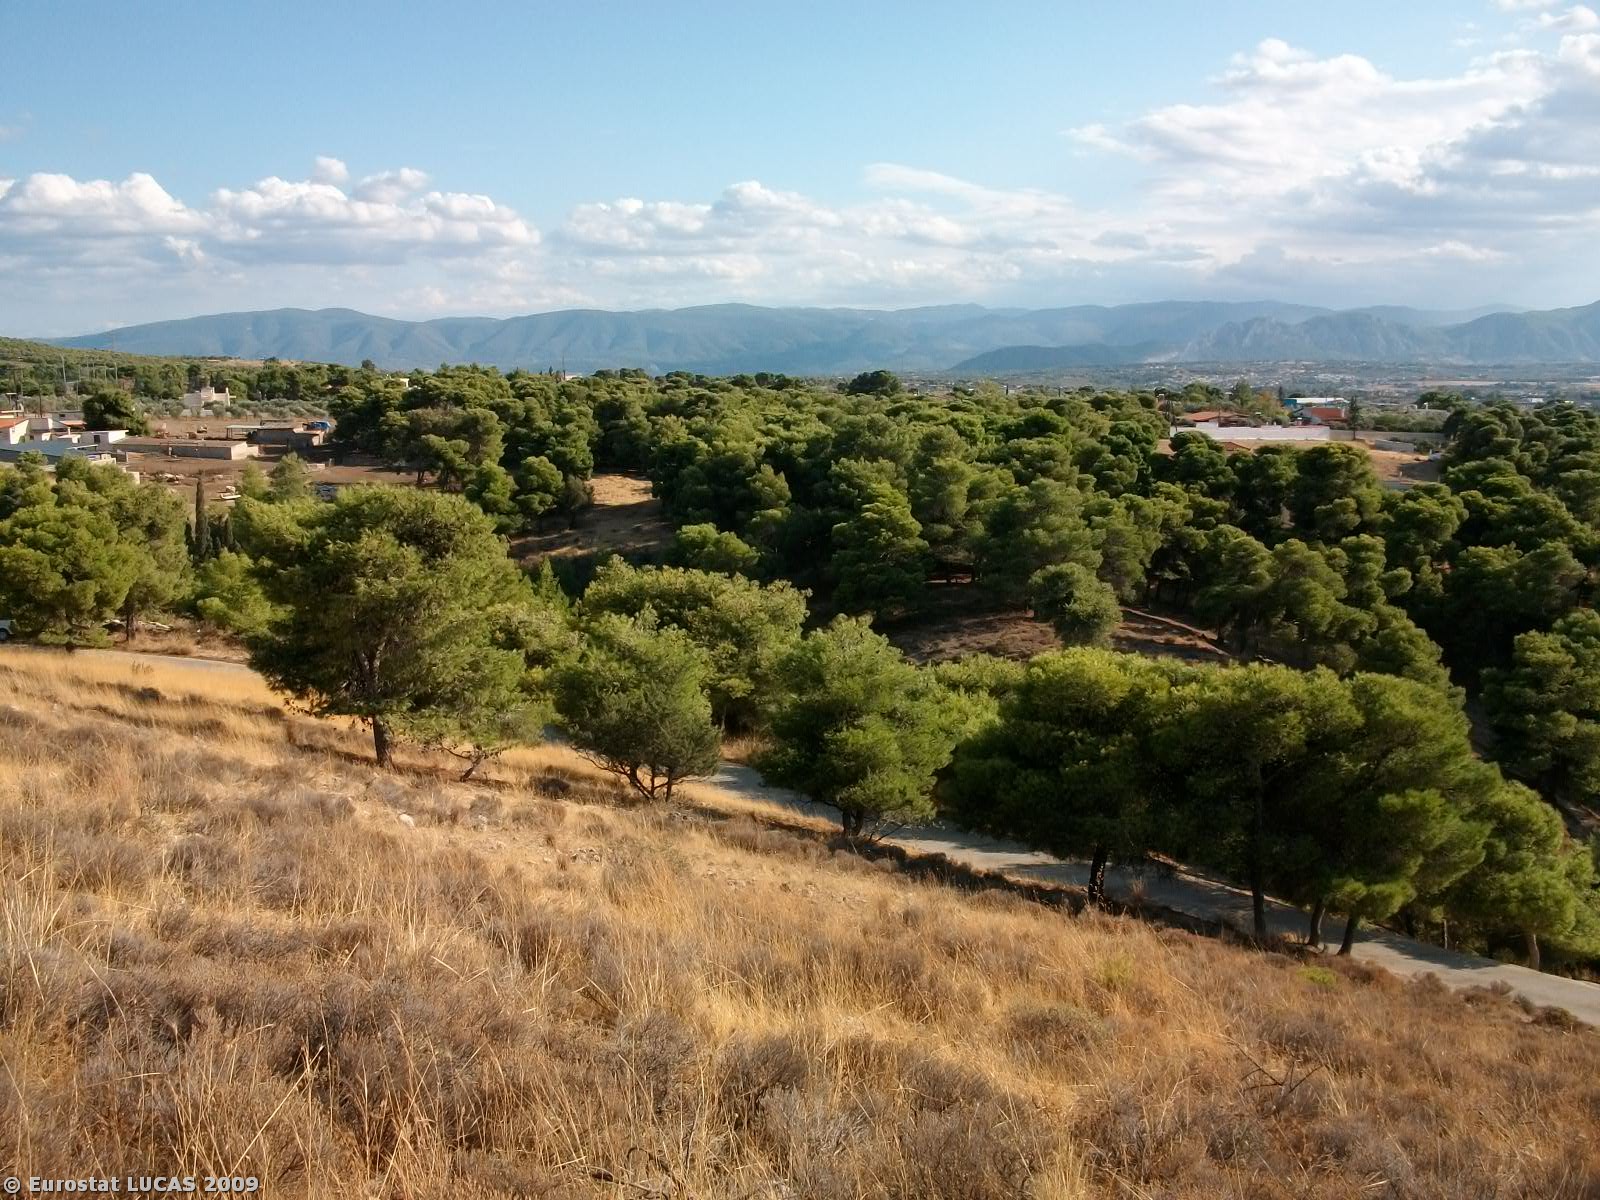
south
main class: Grassland
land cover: Grassland without tree/shrub cover
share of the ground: > 75 %
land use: Unused
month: September
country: GR
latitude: 37.9509
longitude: 23.0035
